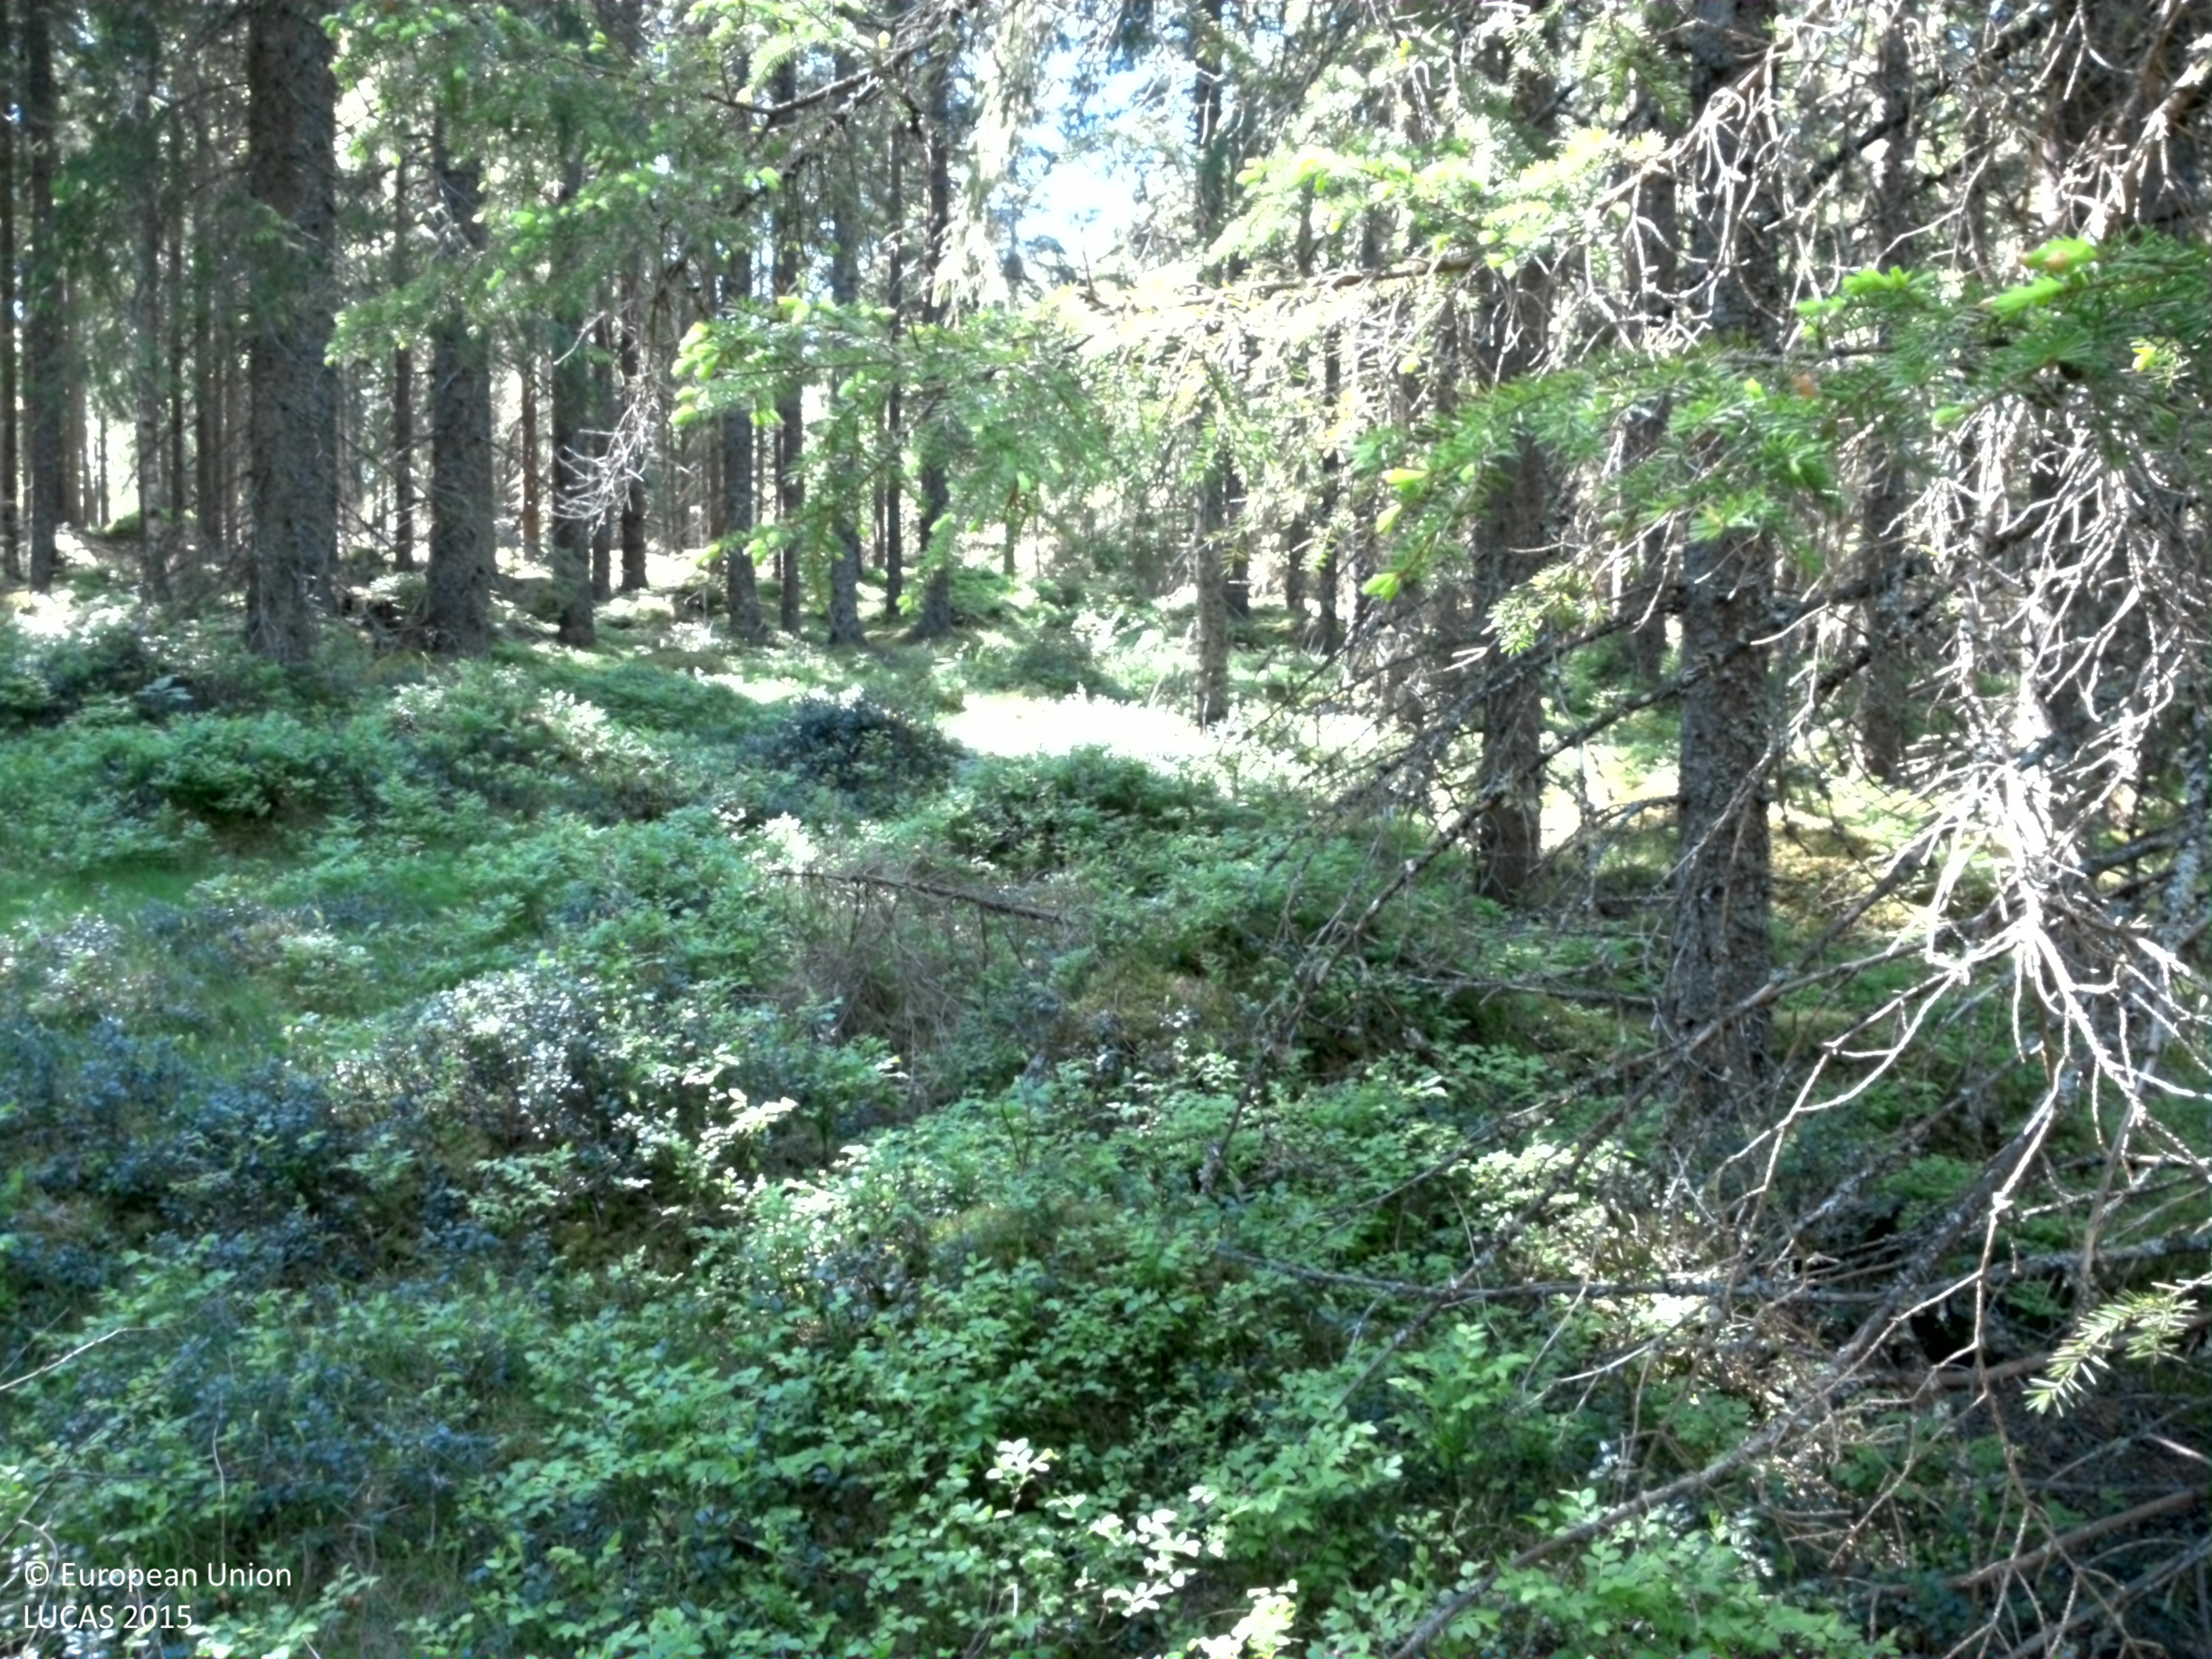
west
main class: Woodland
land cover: Spruce dominated coniferous woodland
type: boreal forest
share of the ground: > 75 %
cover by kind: coniferous forest trees 65 %, shrubs 15 %, broadleaved forest trees 10 %, herbaceous plants 5 %, lichens and mosses 5 %
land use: Forestry
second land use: Community services
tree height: > 5 m
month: June
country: SE
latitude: 59.3443
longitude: 14.7213
